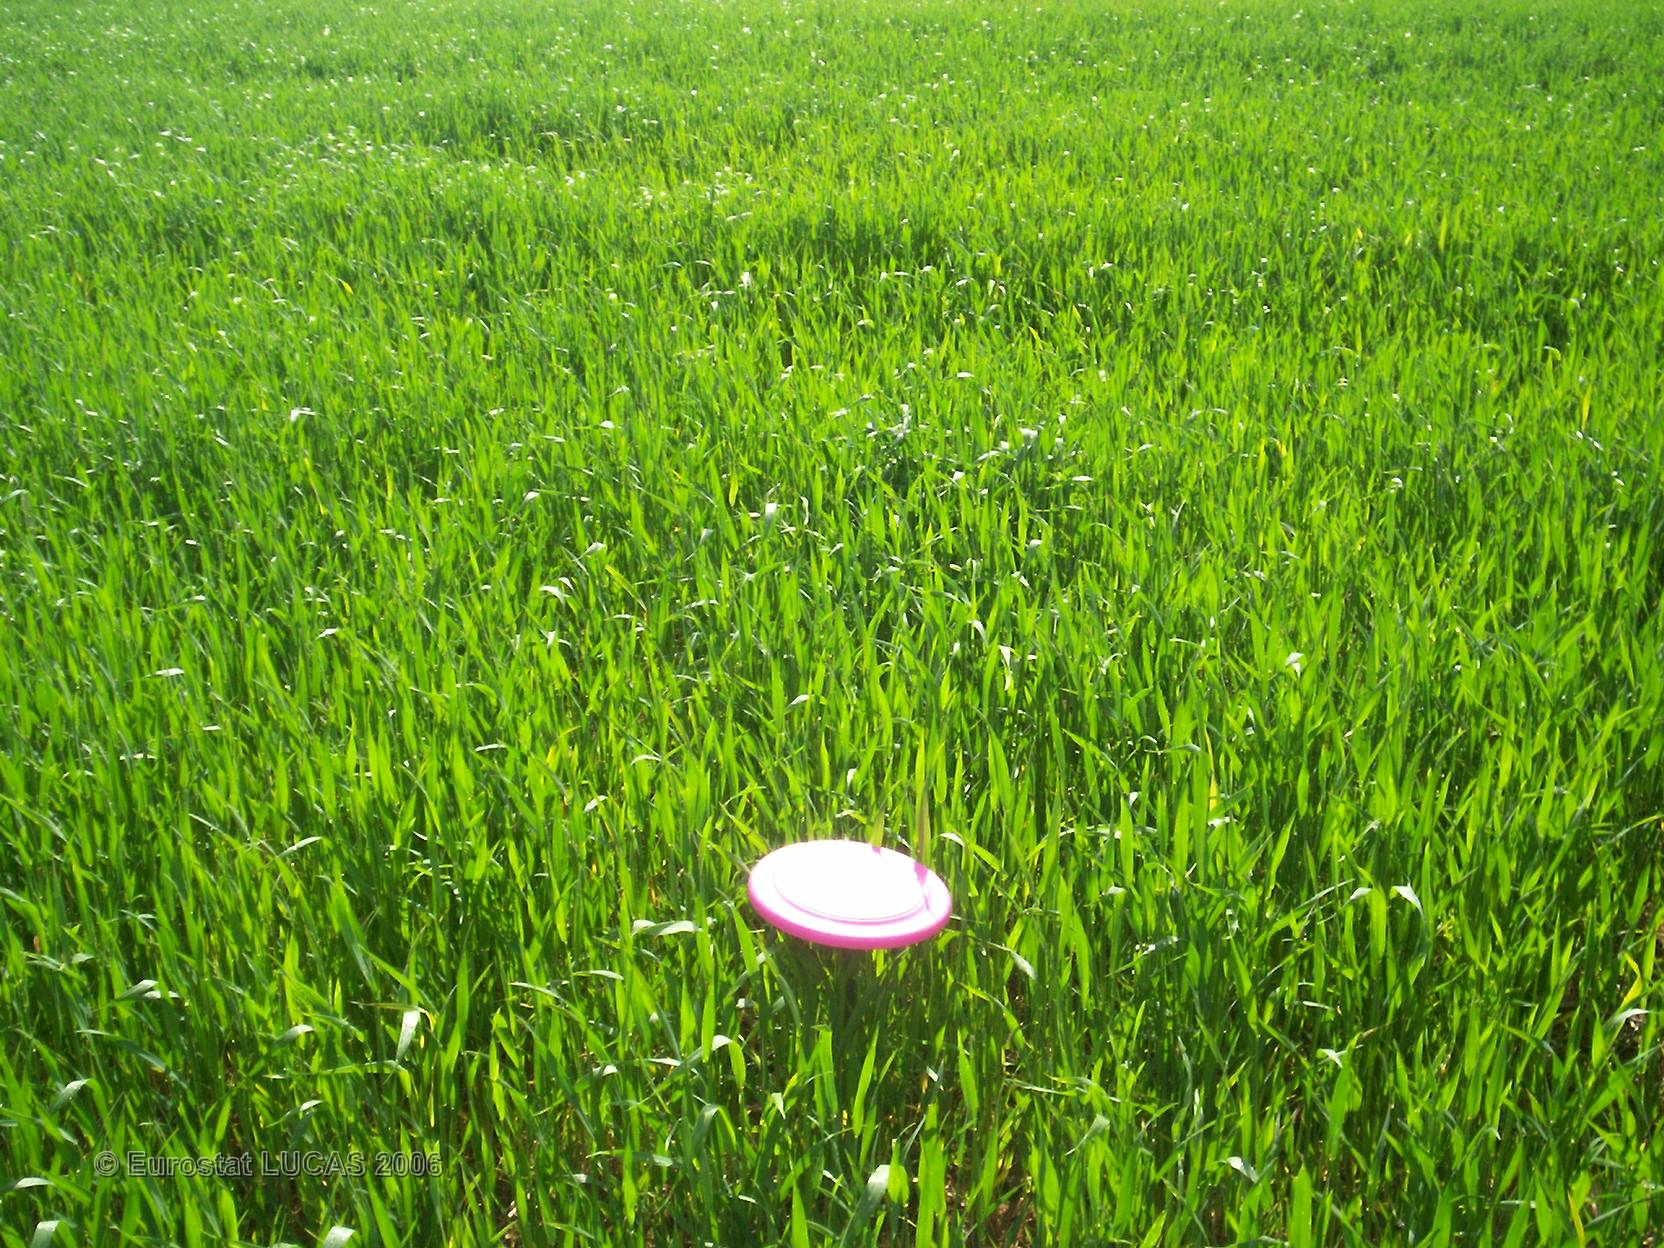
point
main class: Cropland
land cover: Common wheat
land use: Agriculture (excluding fallow land and kitchen gardens)
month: May
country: FR
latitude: 46.9766
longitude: 4.6767
